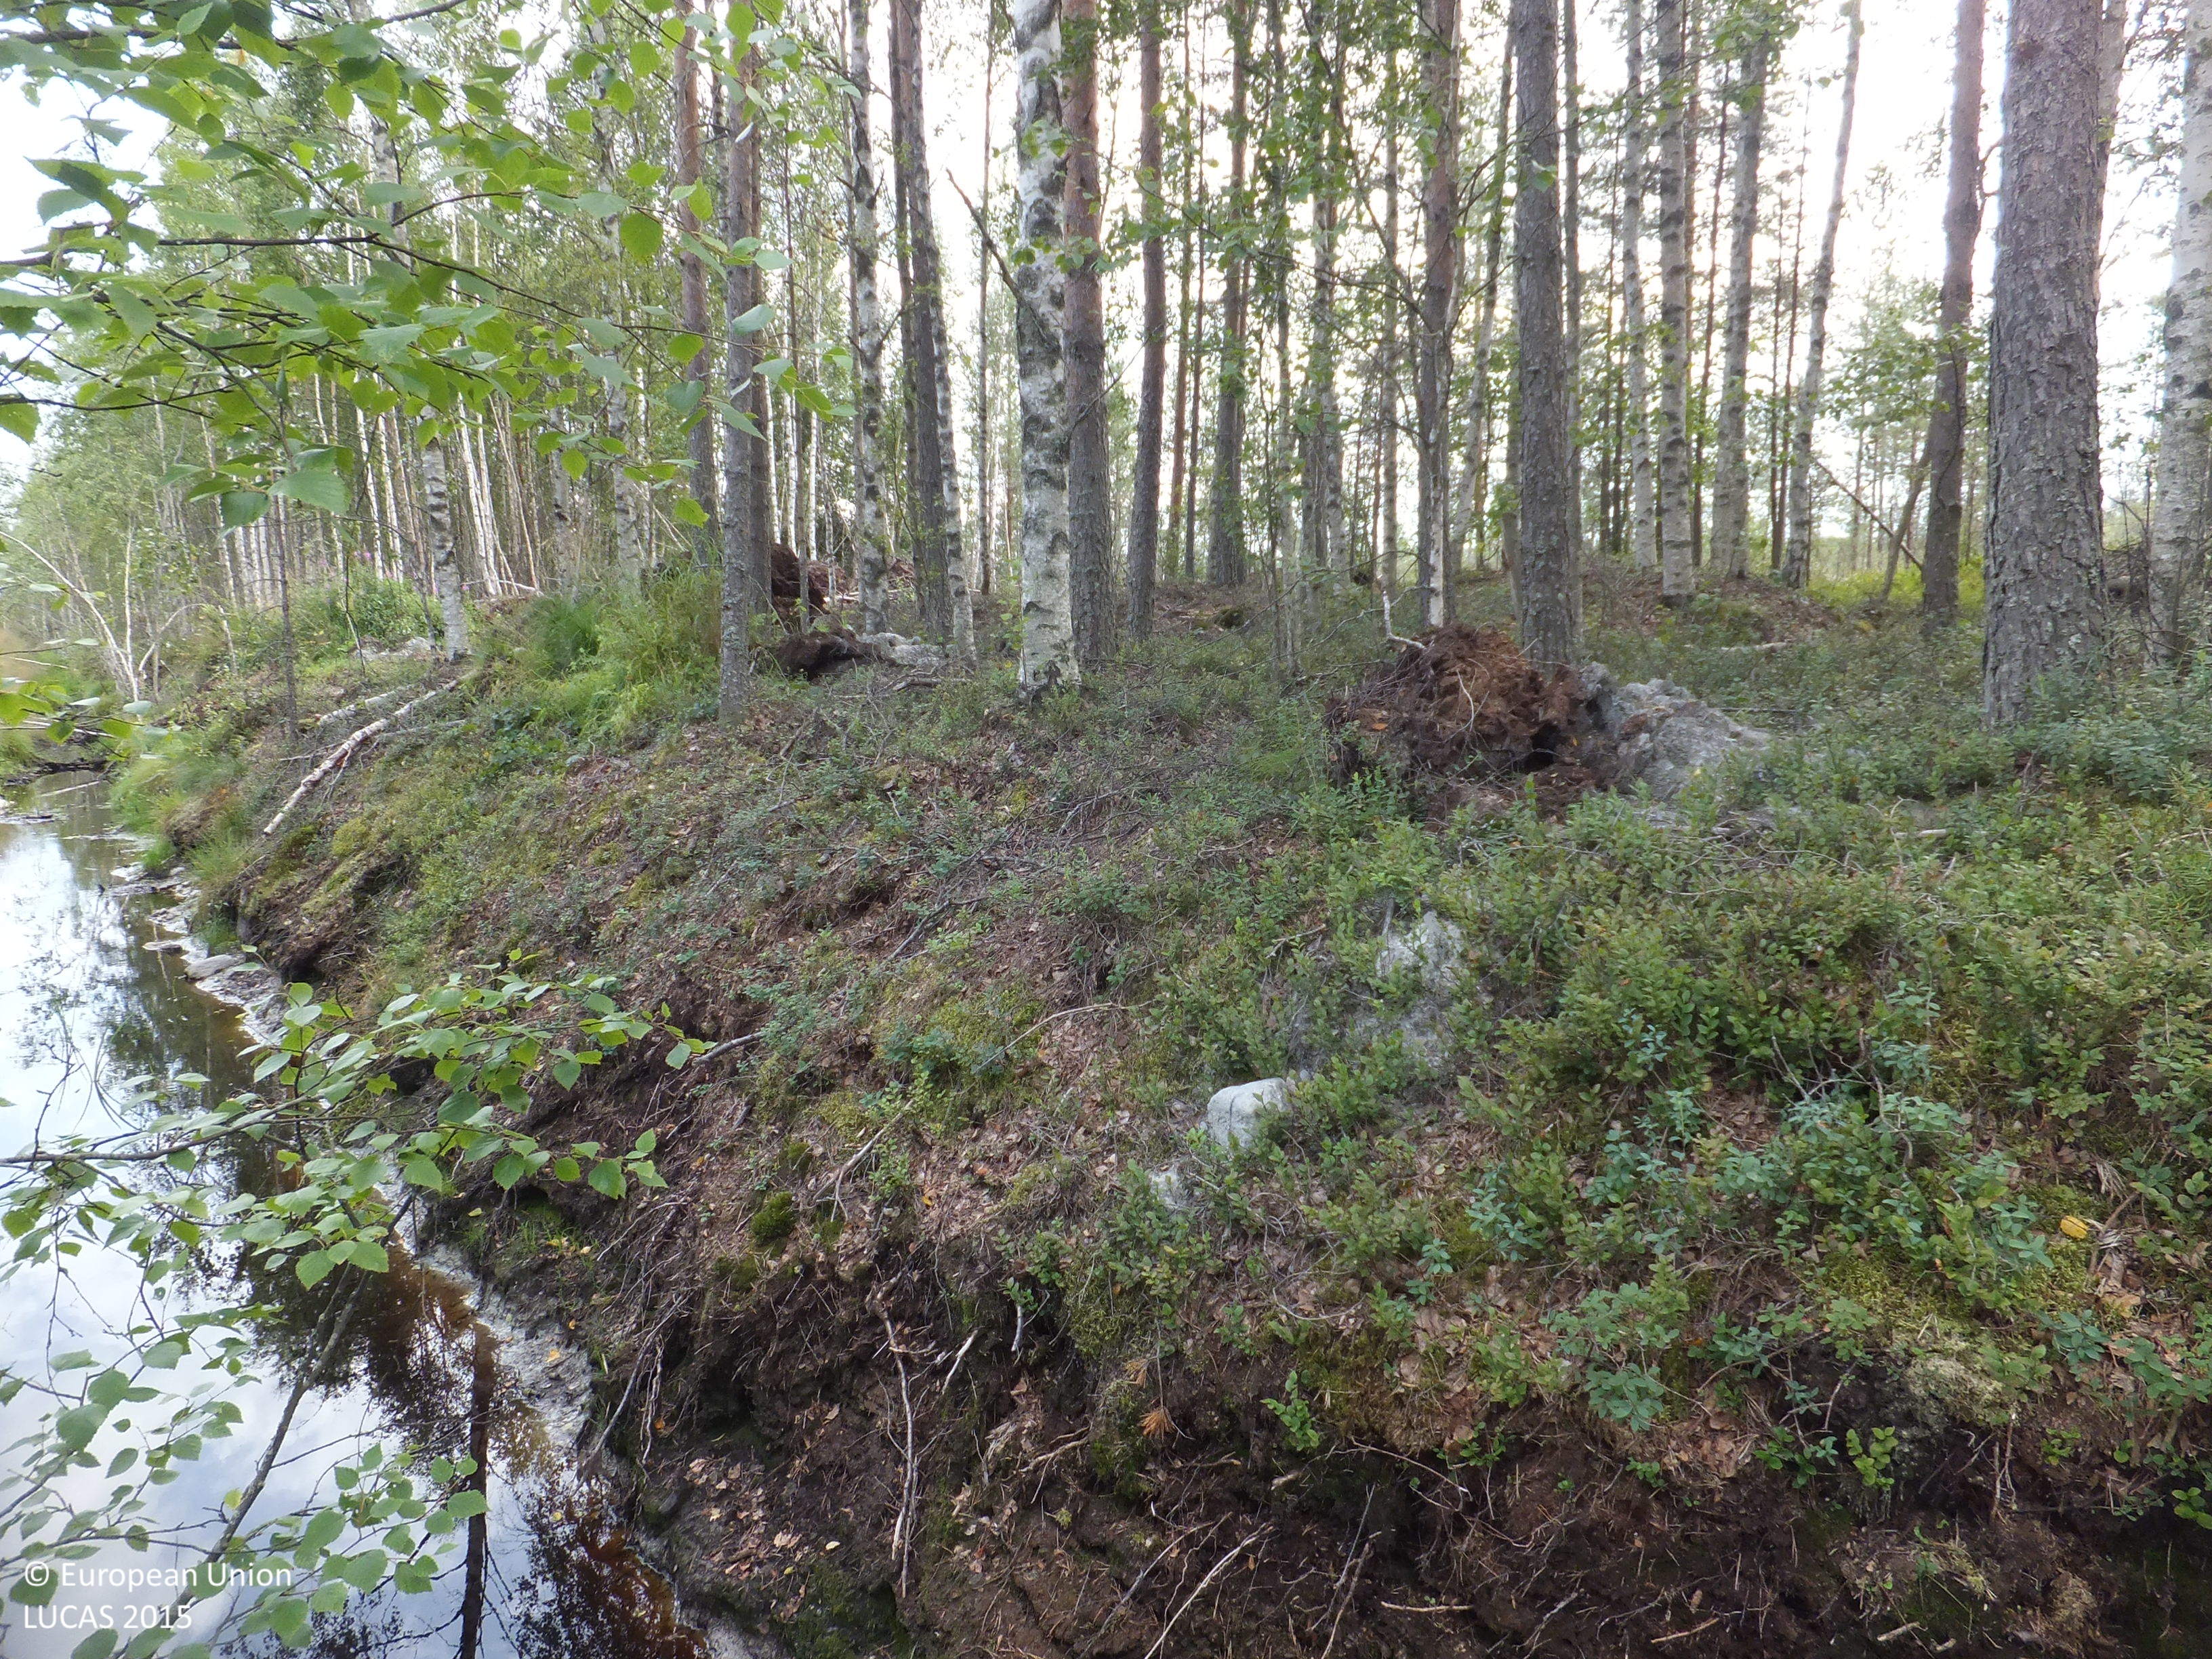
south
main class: Woodland
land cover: Pine dominated coniferous woodland
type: mire and swamp forests
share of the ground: > 75 %
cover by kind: coniferous forest trees 70 %, shrubs 15 %, broadleaved forest trees 5 %, herbaceous plants 5 %, lichens and mosses 5 %
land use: Forestry
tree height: > 5 m
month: August
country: FI
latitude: 63.1946
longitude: 22.6333
